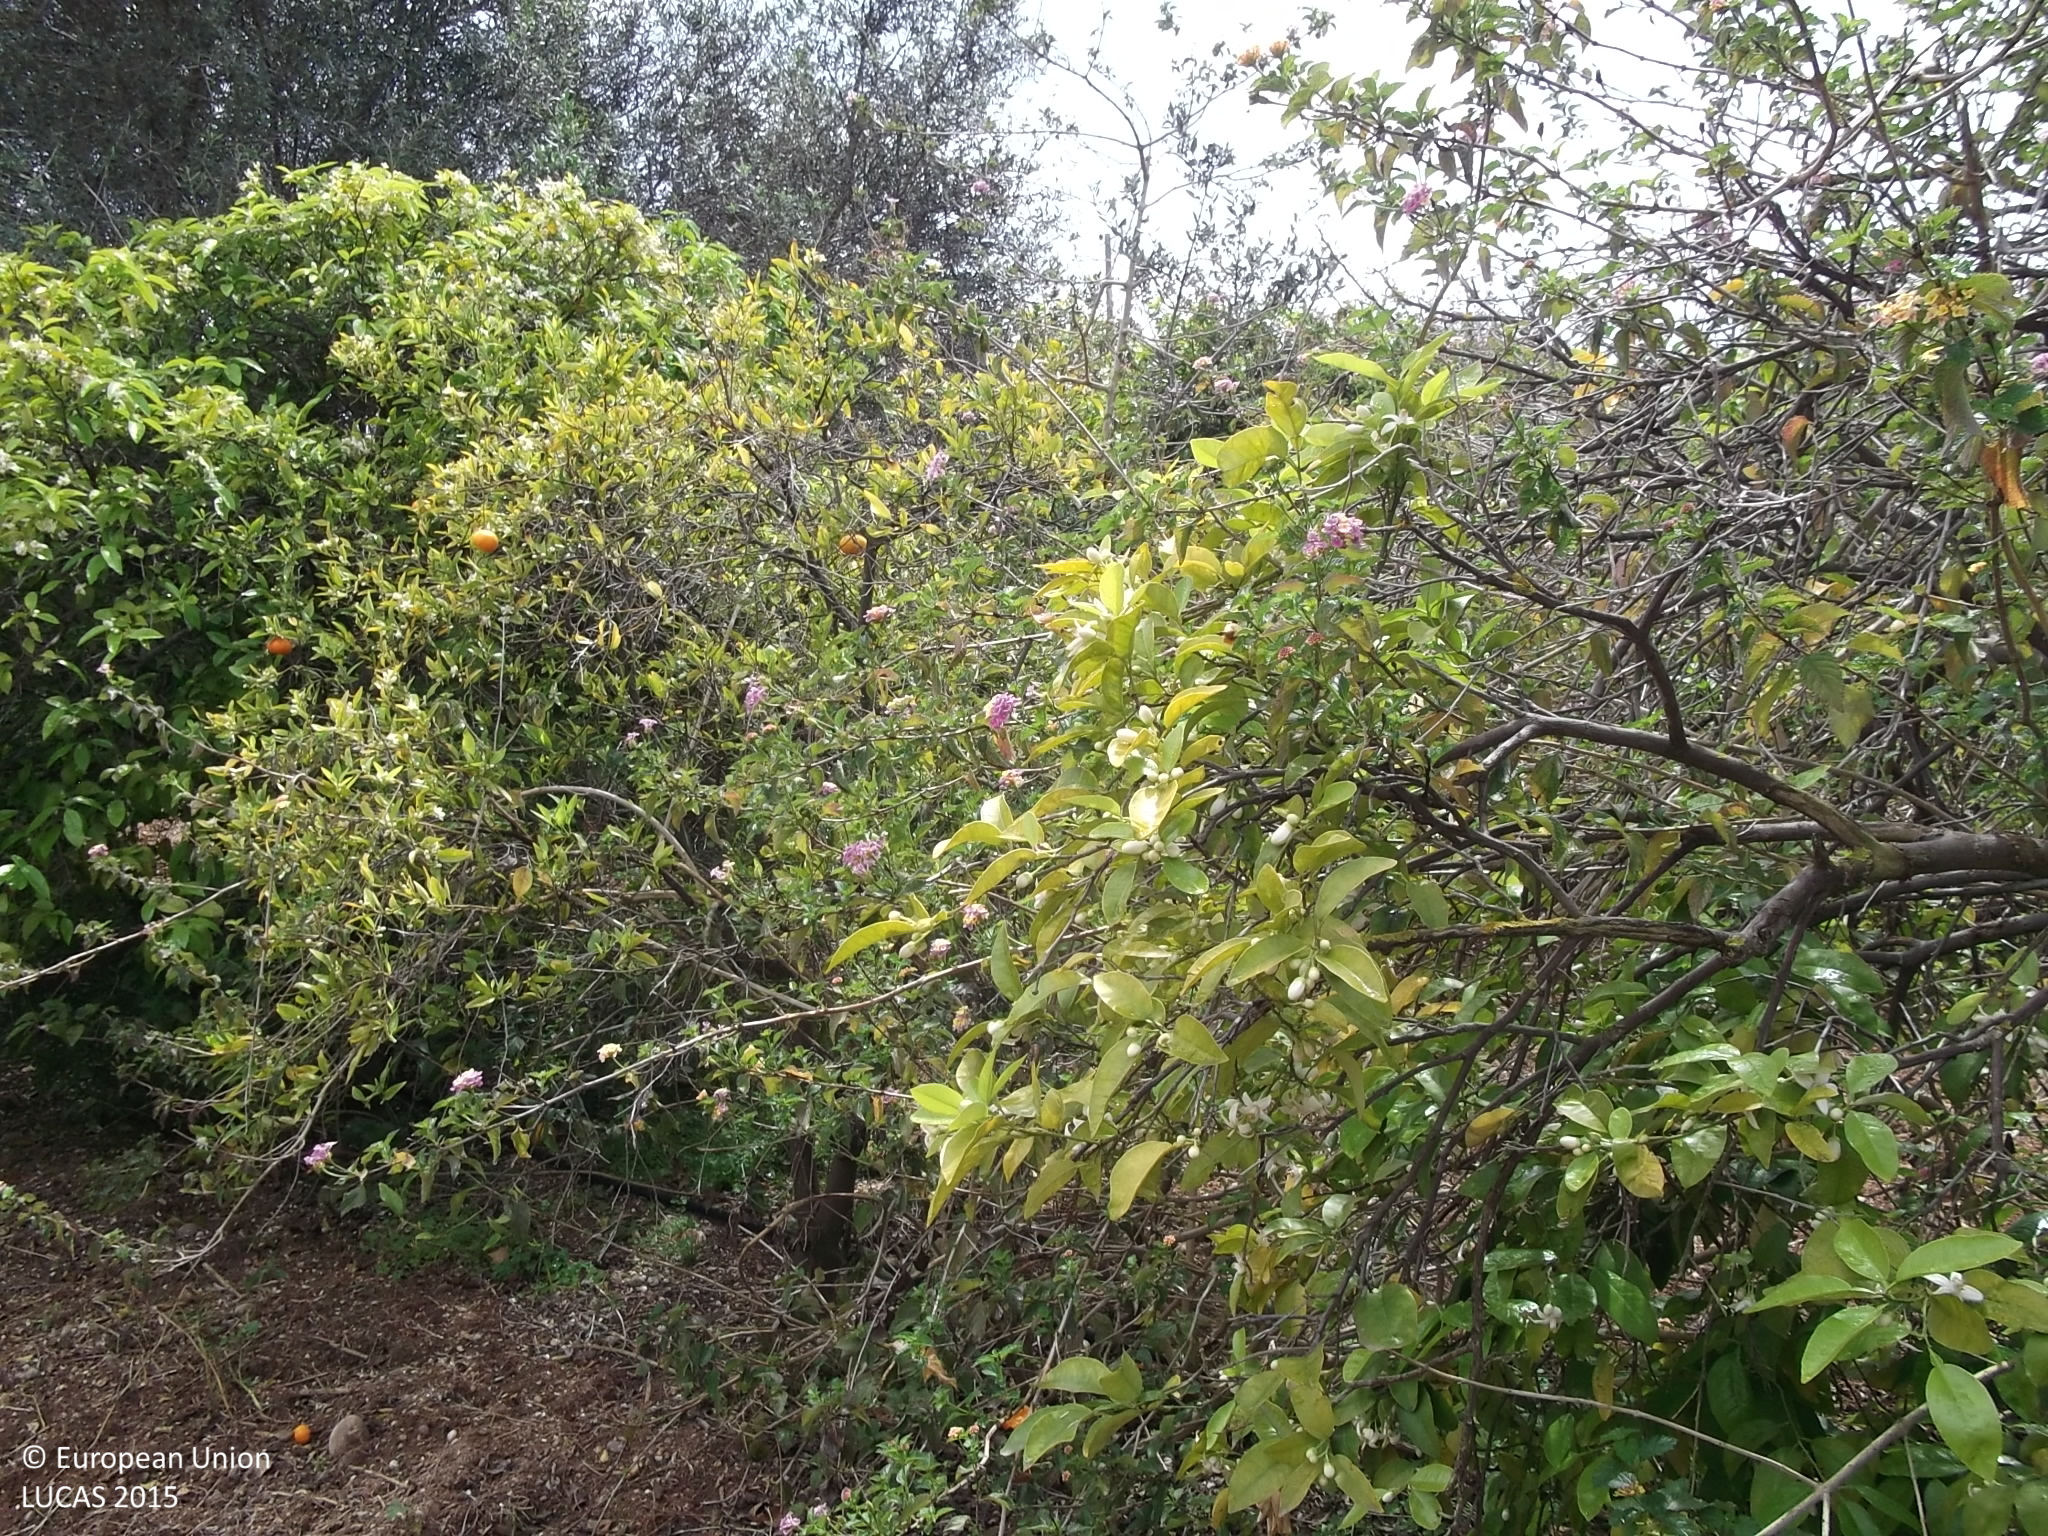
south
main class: Cropland
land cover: Other citrus fruit
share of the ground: > 75 %
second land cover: Other bare soil
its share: > 75 %
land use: Agriculture (excluding fallow land and kitchen gardens)
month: April
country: CY
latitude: 34.7606
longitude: 33.4200
